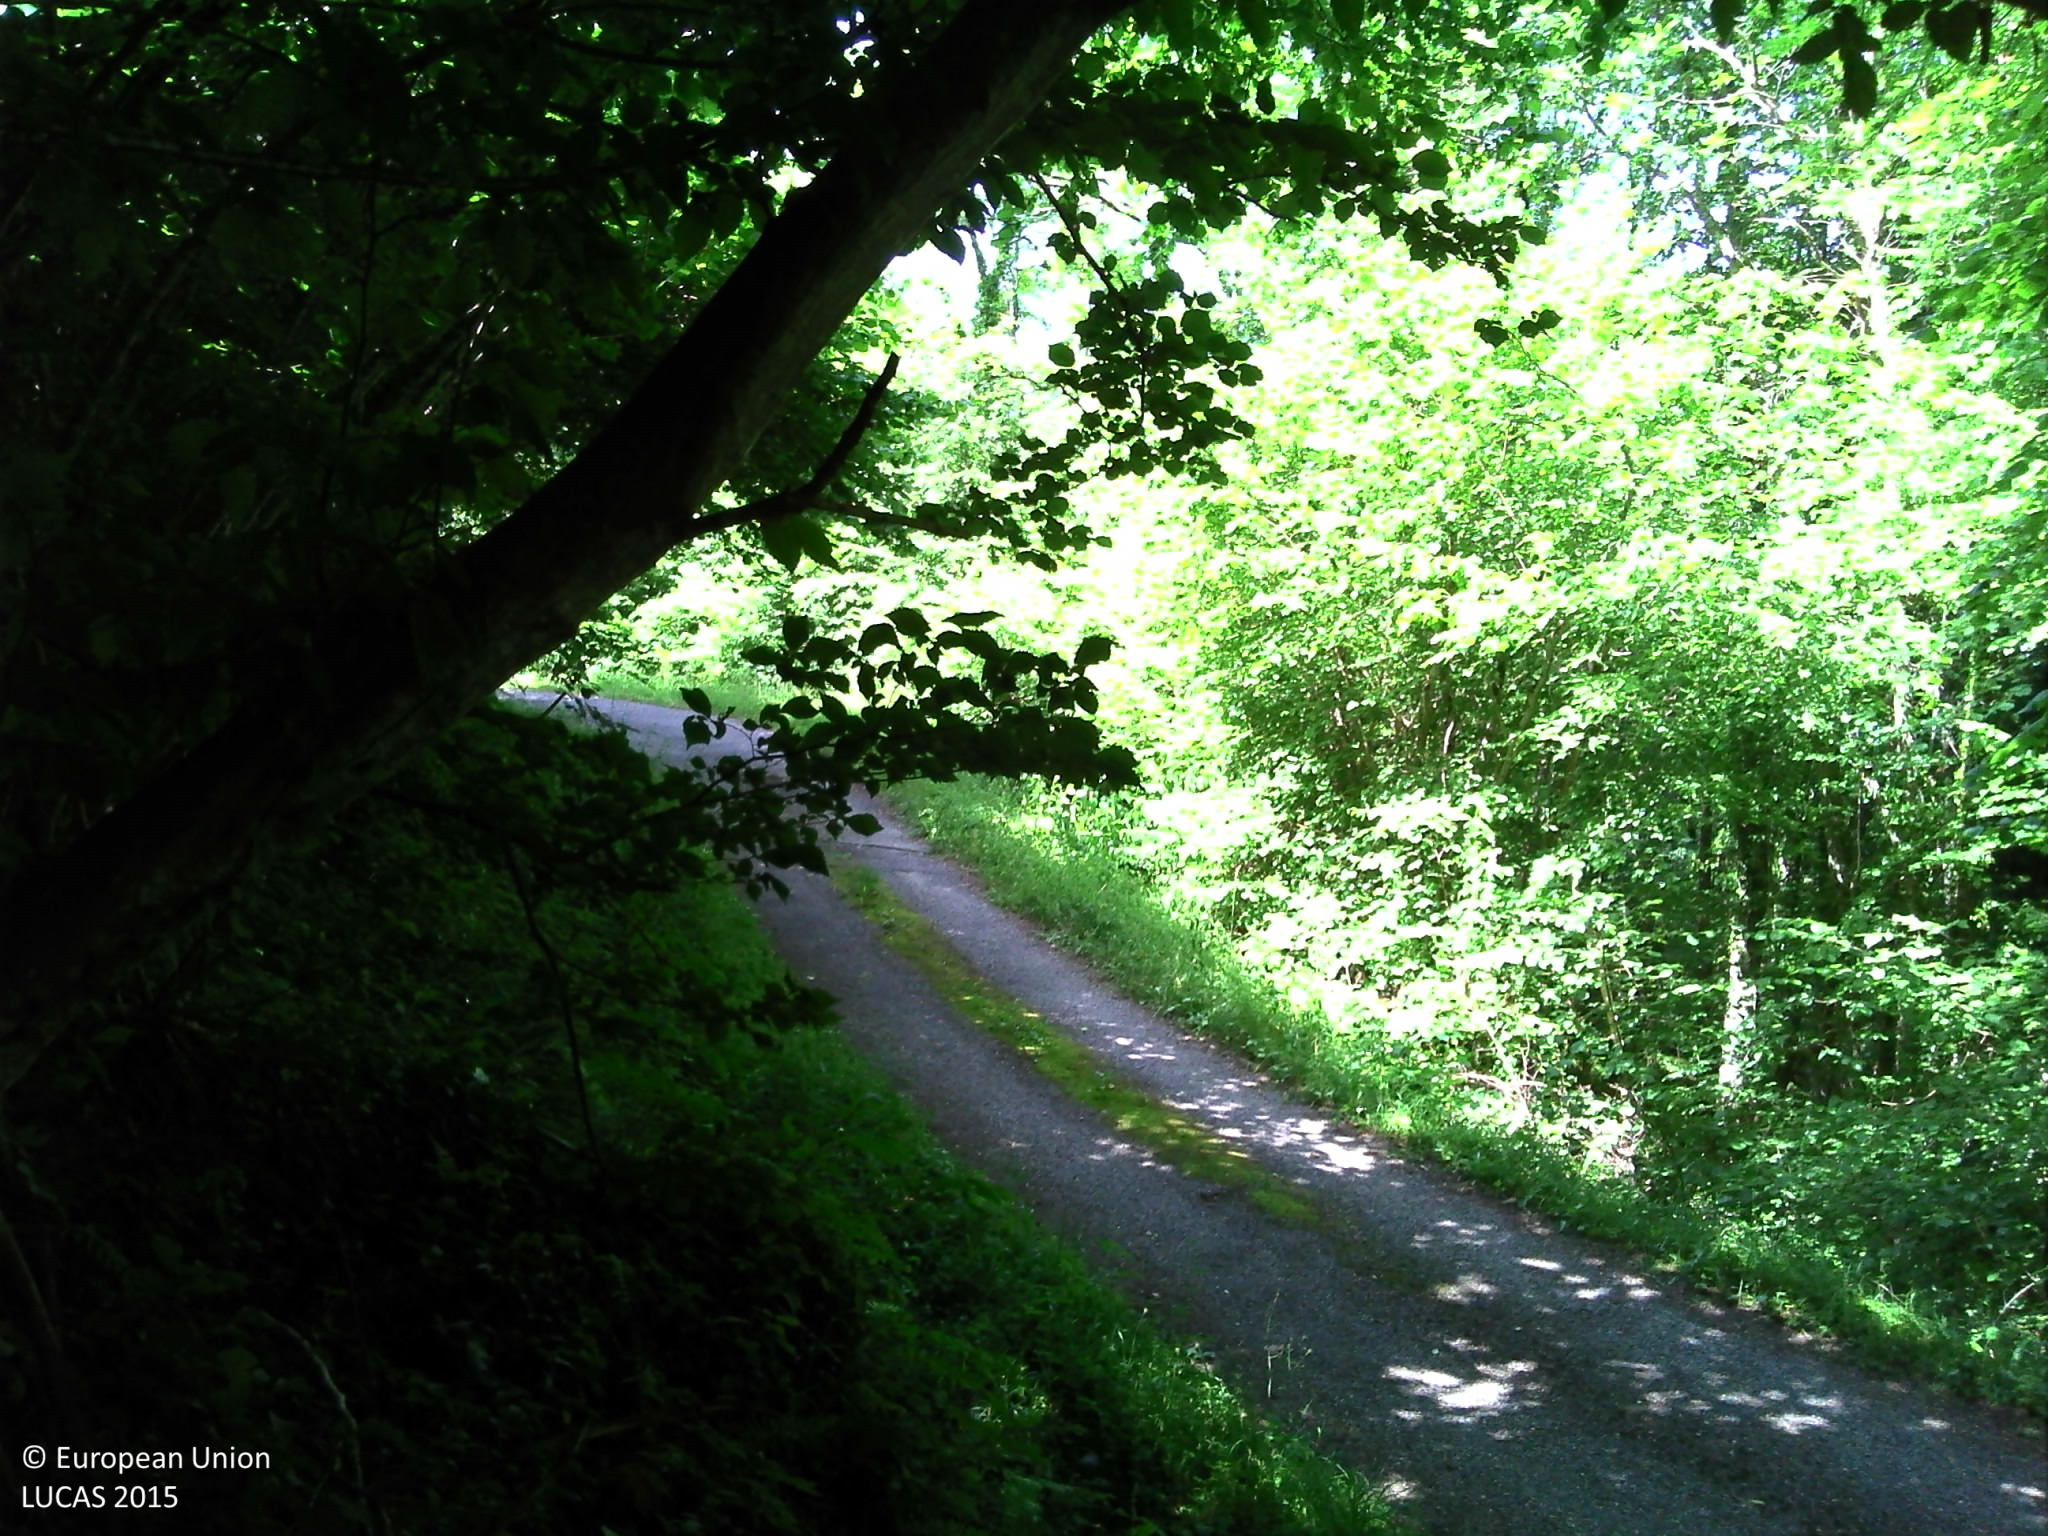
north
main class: Woodland
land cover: Broadleaved woodland
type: mesophytic deciduous forest
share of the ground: > 75 %
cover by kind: broadleaved forest trees 50 %, consolidated bare surface 30 %, shrubs 10 %, herbaceous plants 10 %
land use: Forestry
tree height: > 5 m
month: July
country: FR
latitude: 42.9695
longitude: 0.8940
